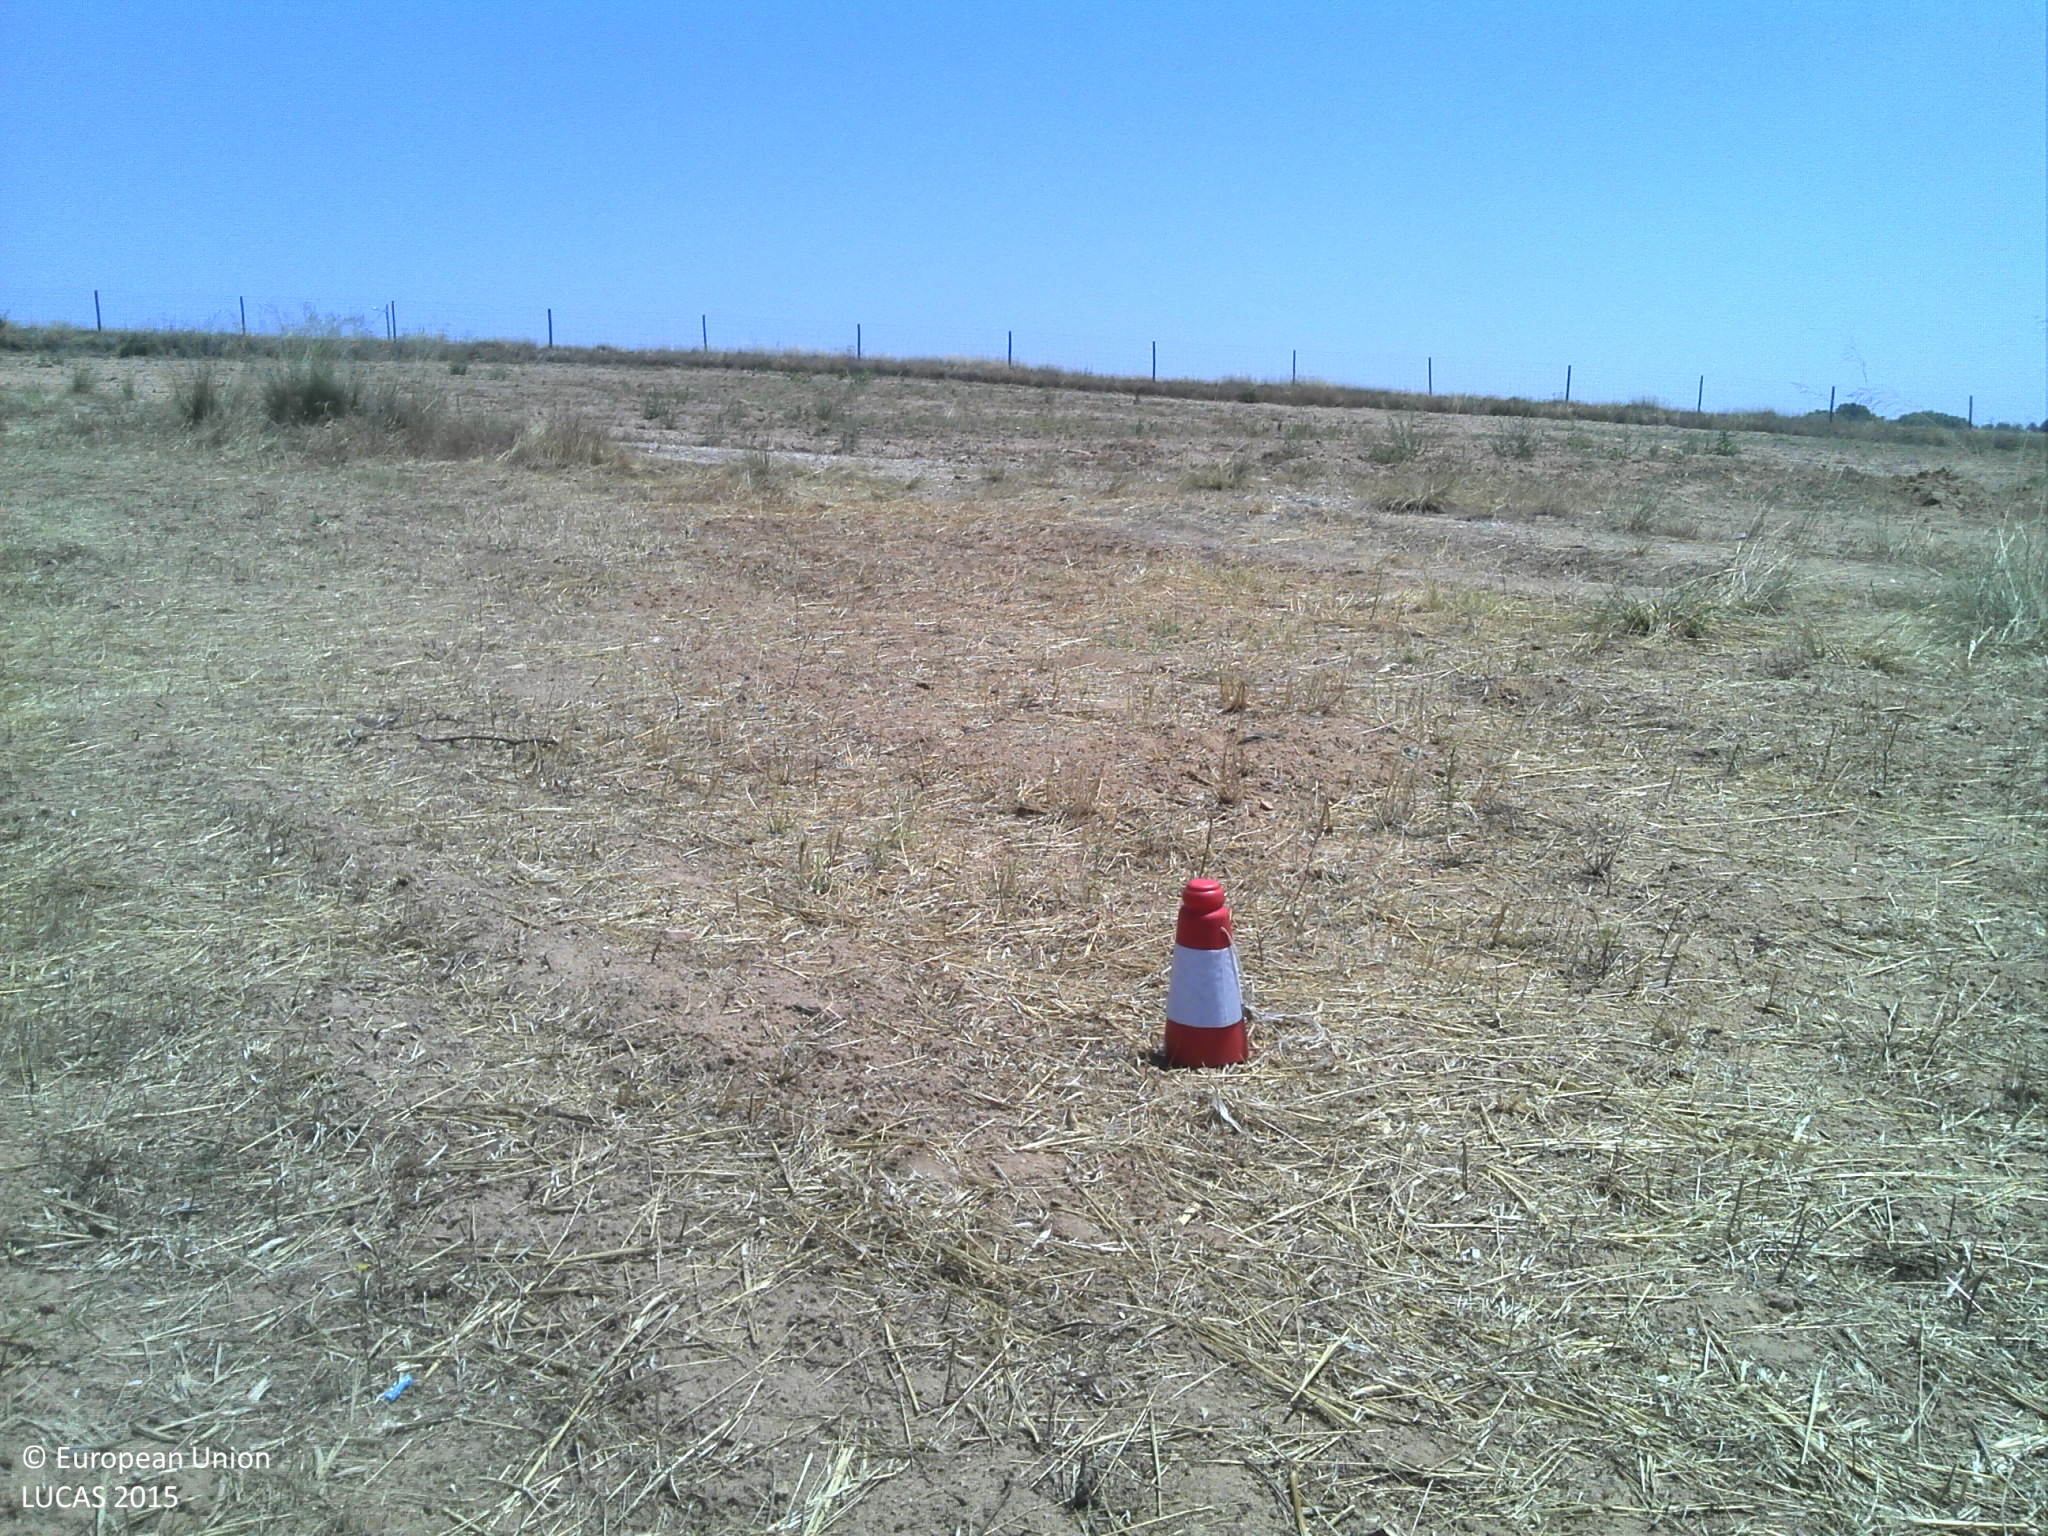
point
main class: Grassland
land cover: Grassland without tree/shrub cover
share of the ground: 10 - 25 %
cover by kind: unconsolidated bare surface 85 %, herbaceous plants 10 %
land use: Agriculture (excluding fallow land and kitchen gardens)
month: June
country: PT
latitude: 39.8453
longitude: -7.2860
